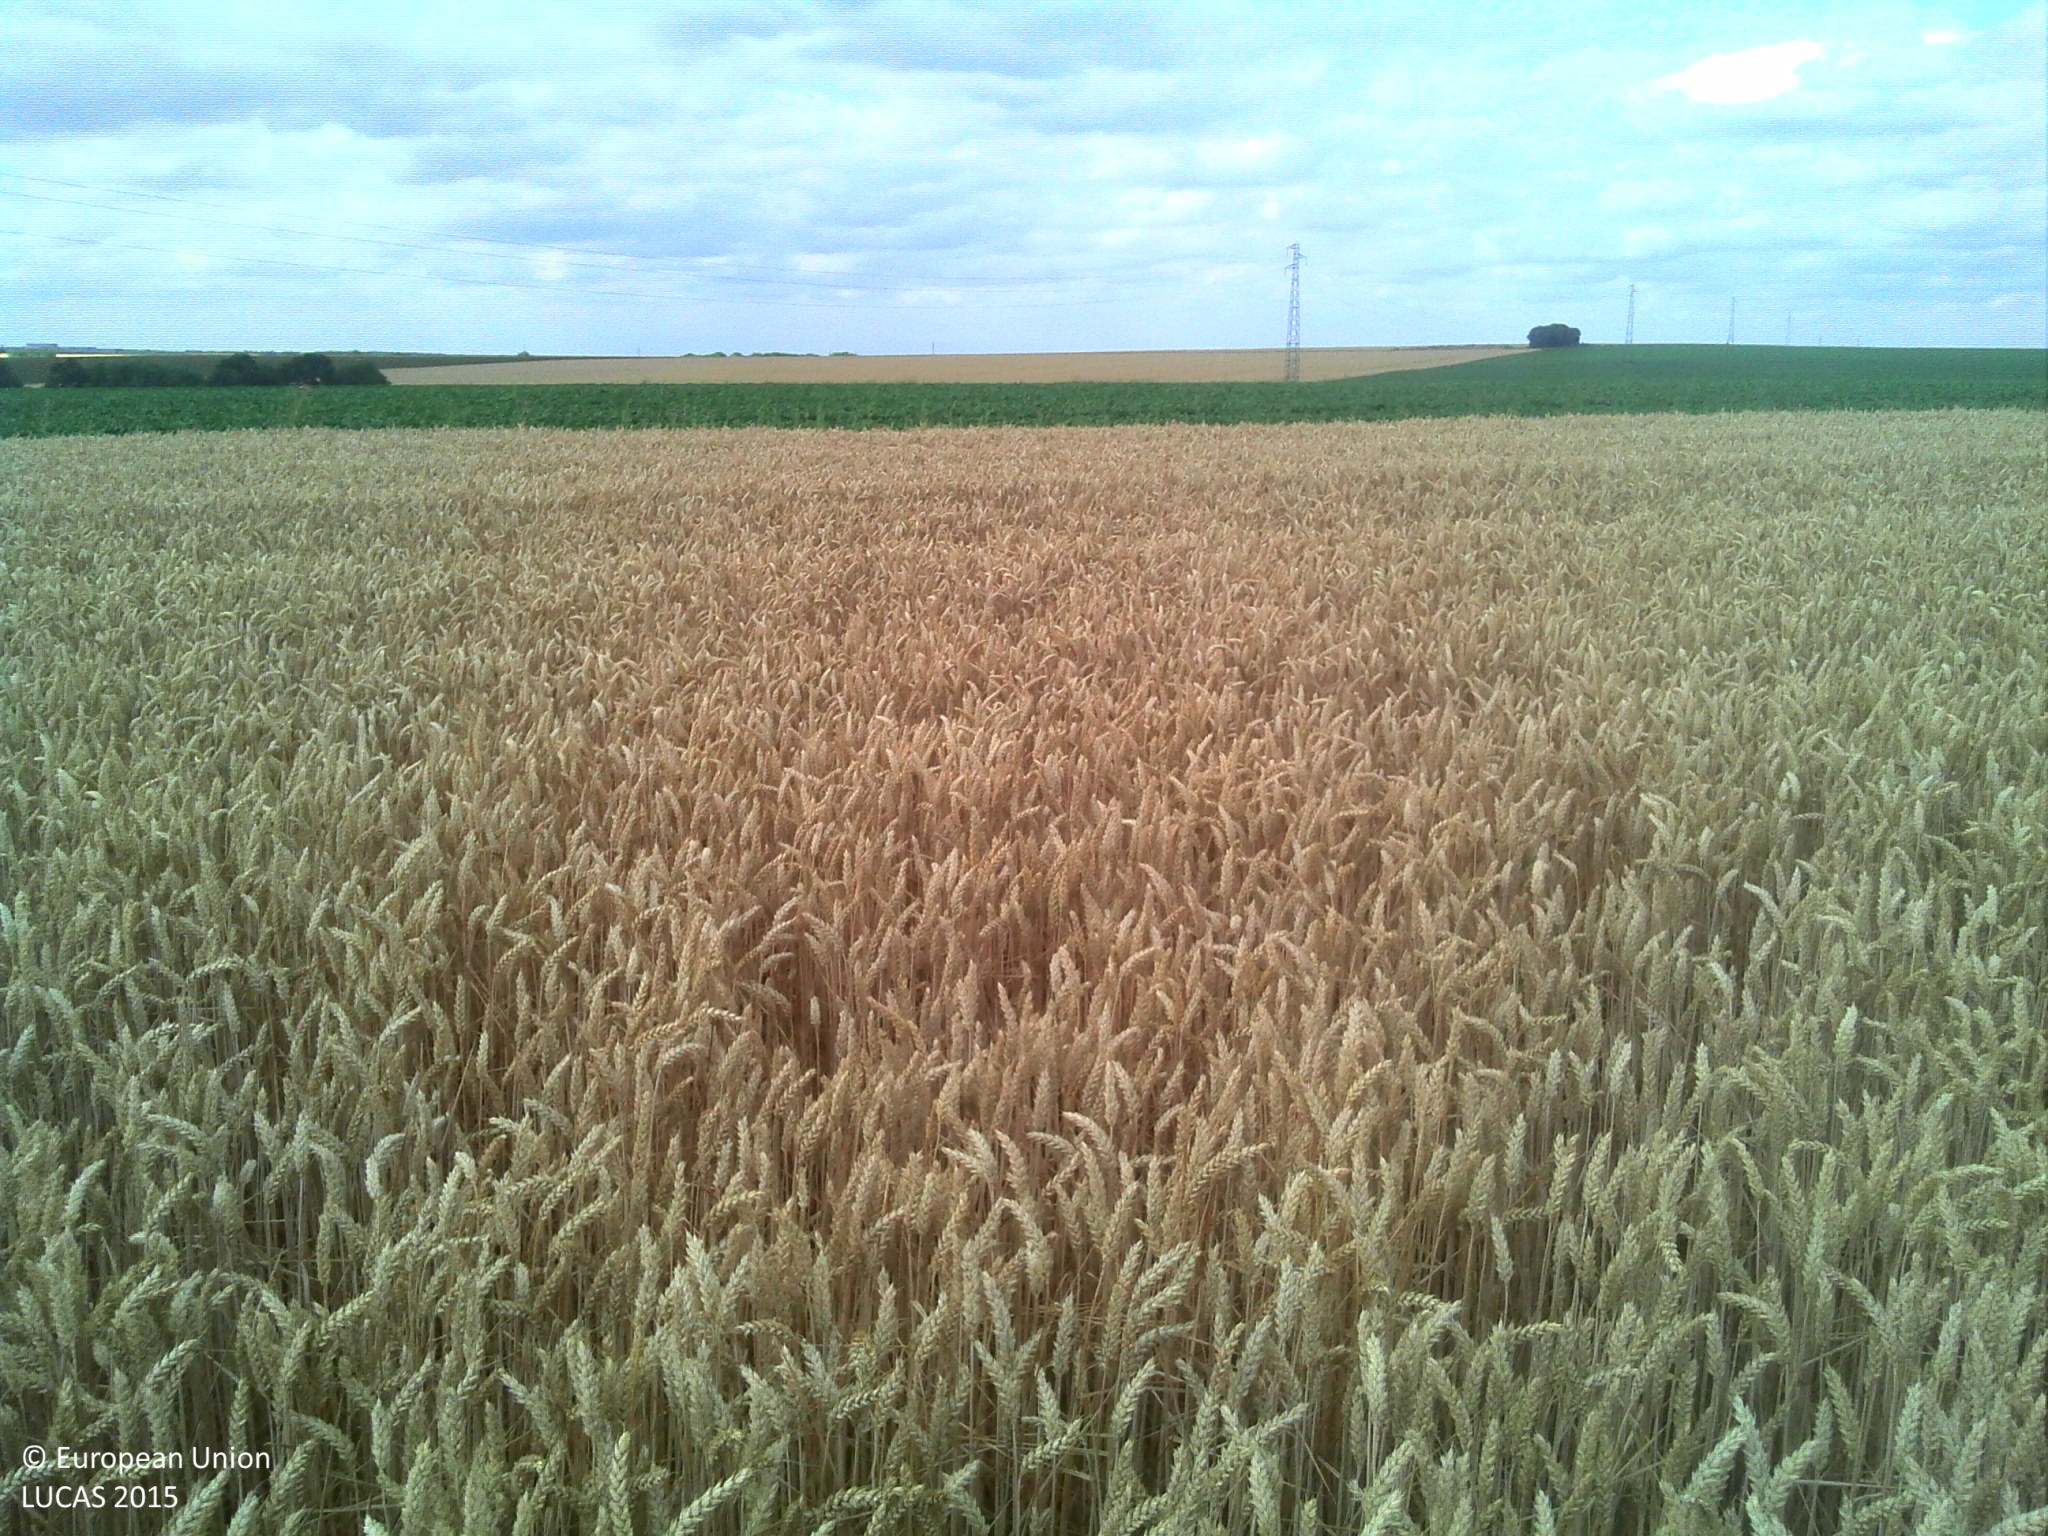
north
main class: Cropland
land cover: Common wheat
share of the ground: > 75 %
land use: Agriculture (excluding fallow land and kitchen gardens)
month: July
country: FR
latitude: 49.2831
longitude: 3.2973
